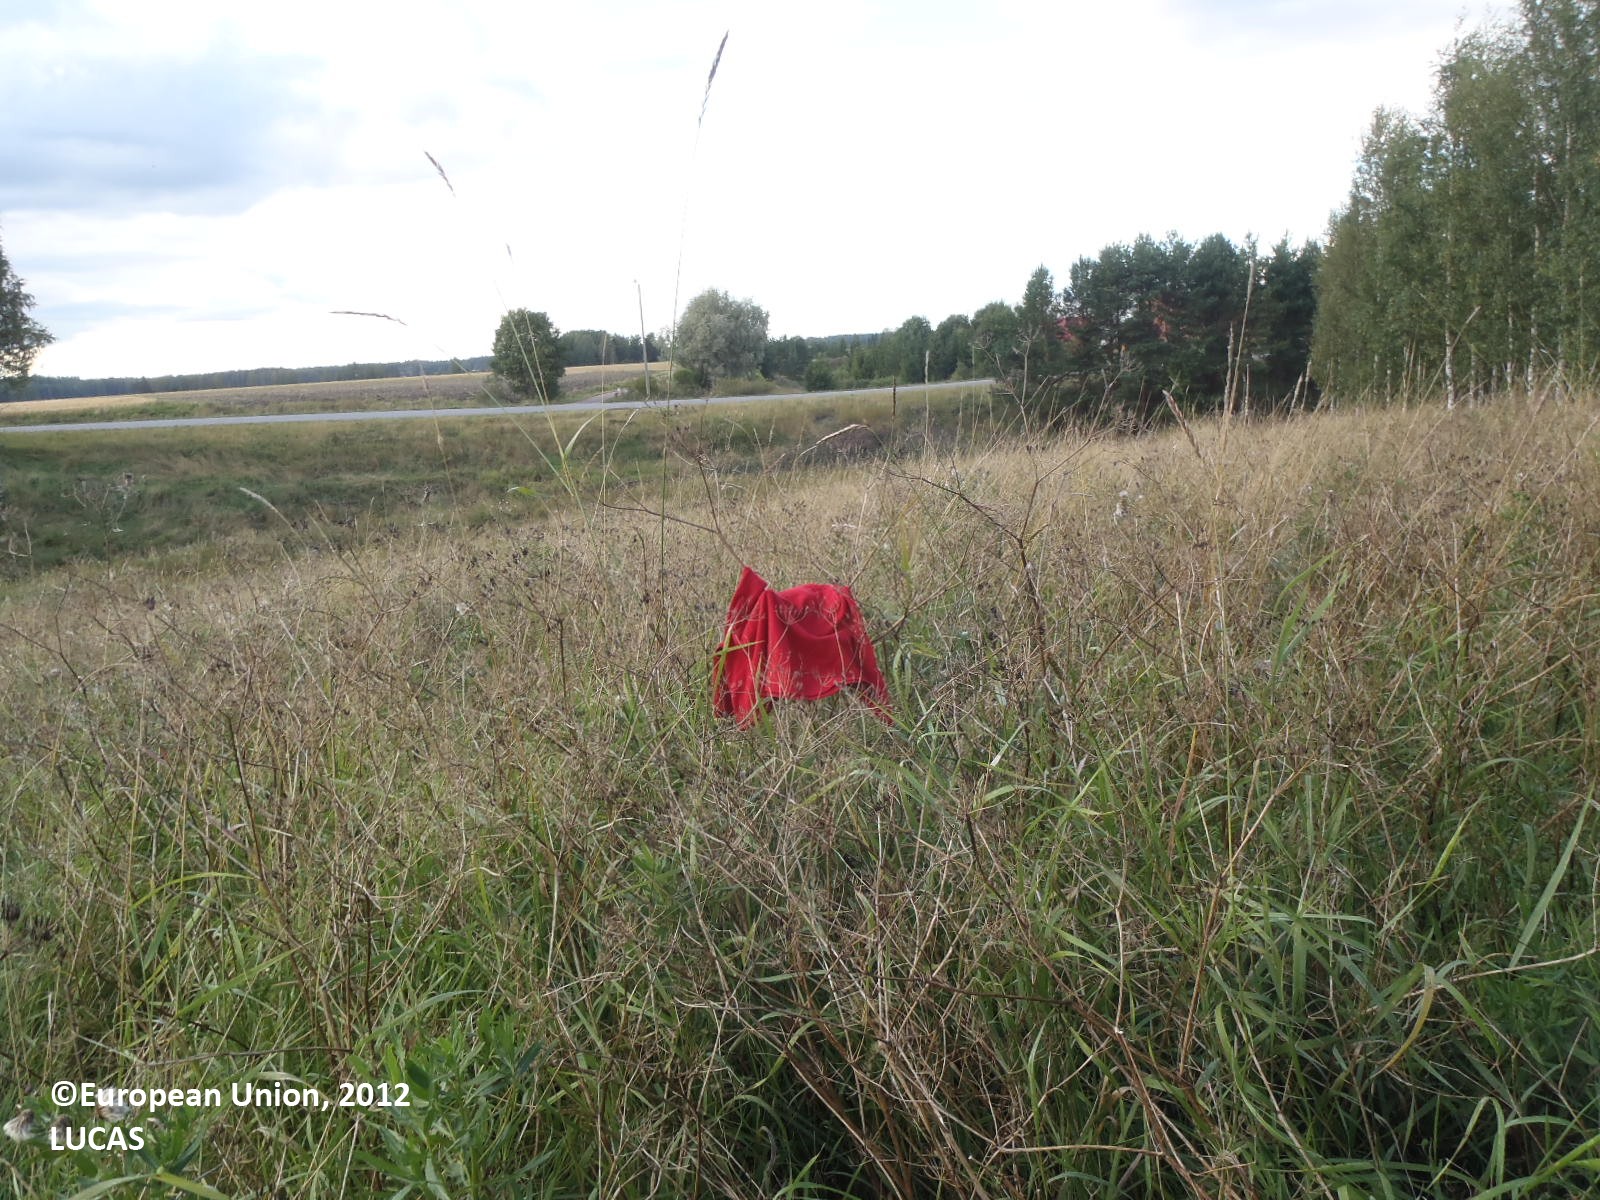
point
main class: Grassland
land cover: Grassland without tree/shrub cover
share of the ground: > 75 %
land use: Fallow land
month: August
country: FI
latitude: 60.6203
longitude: 22.7735
